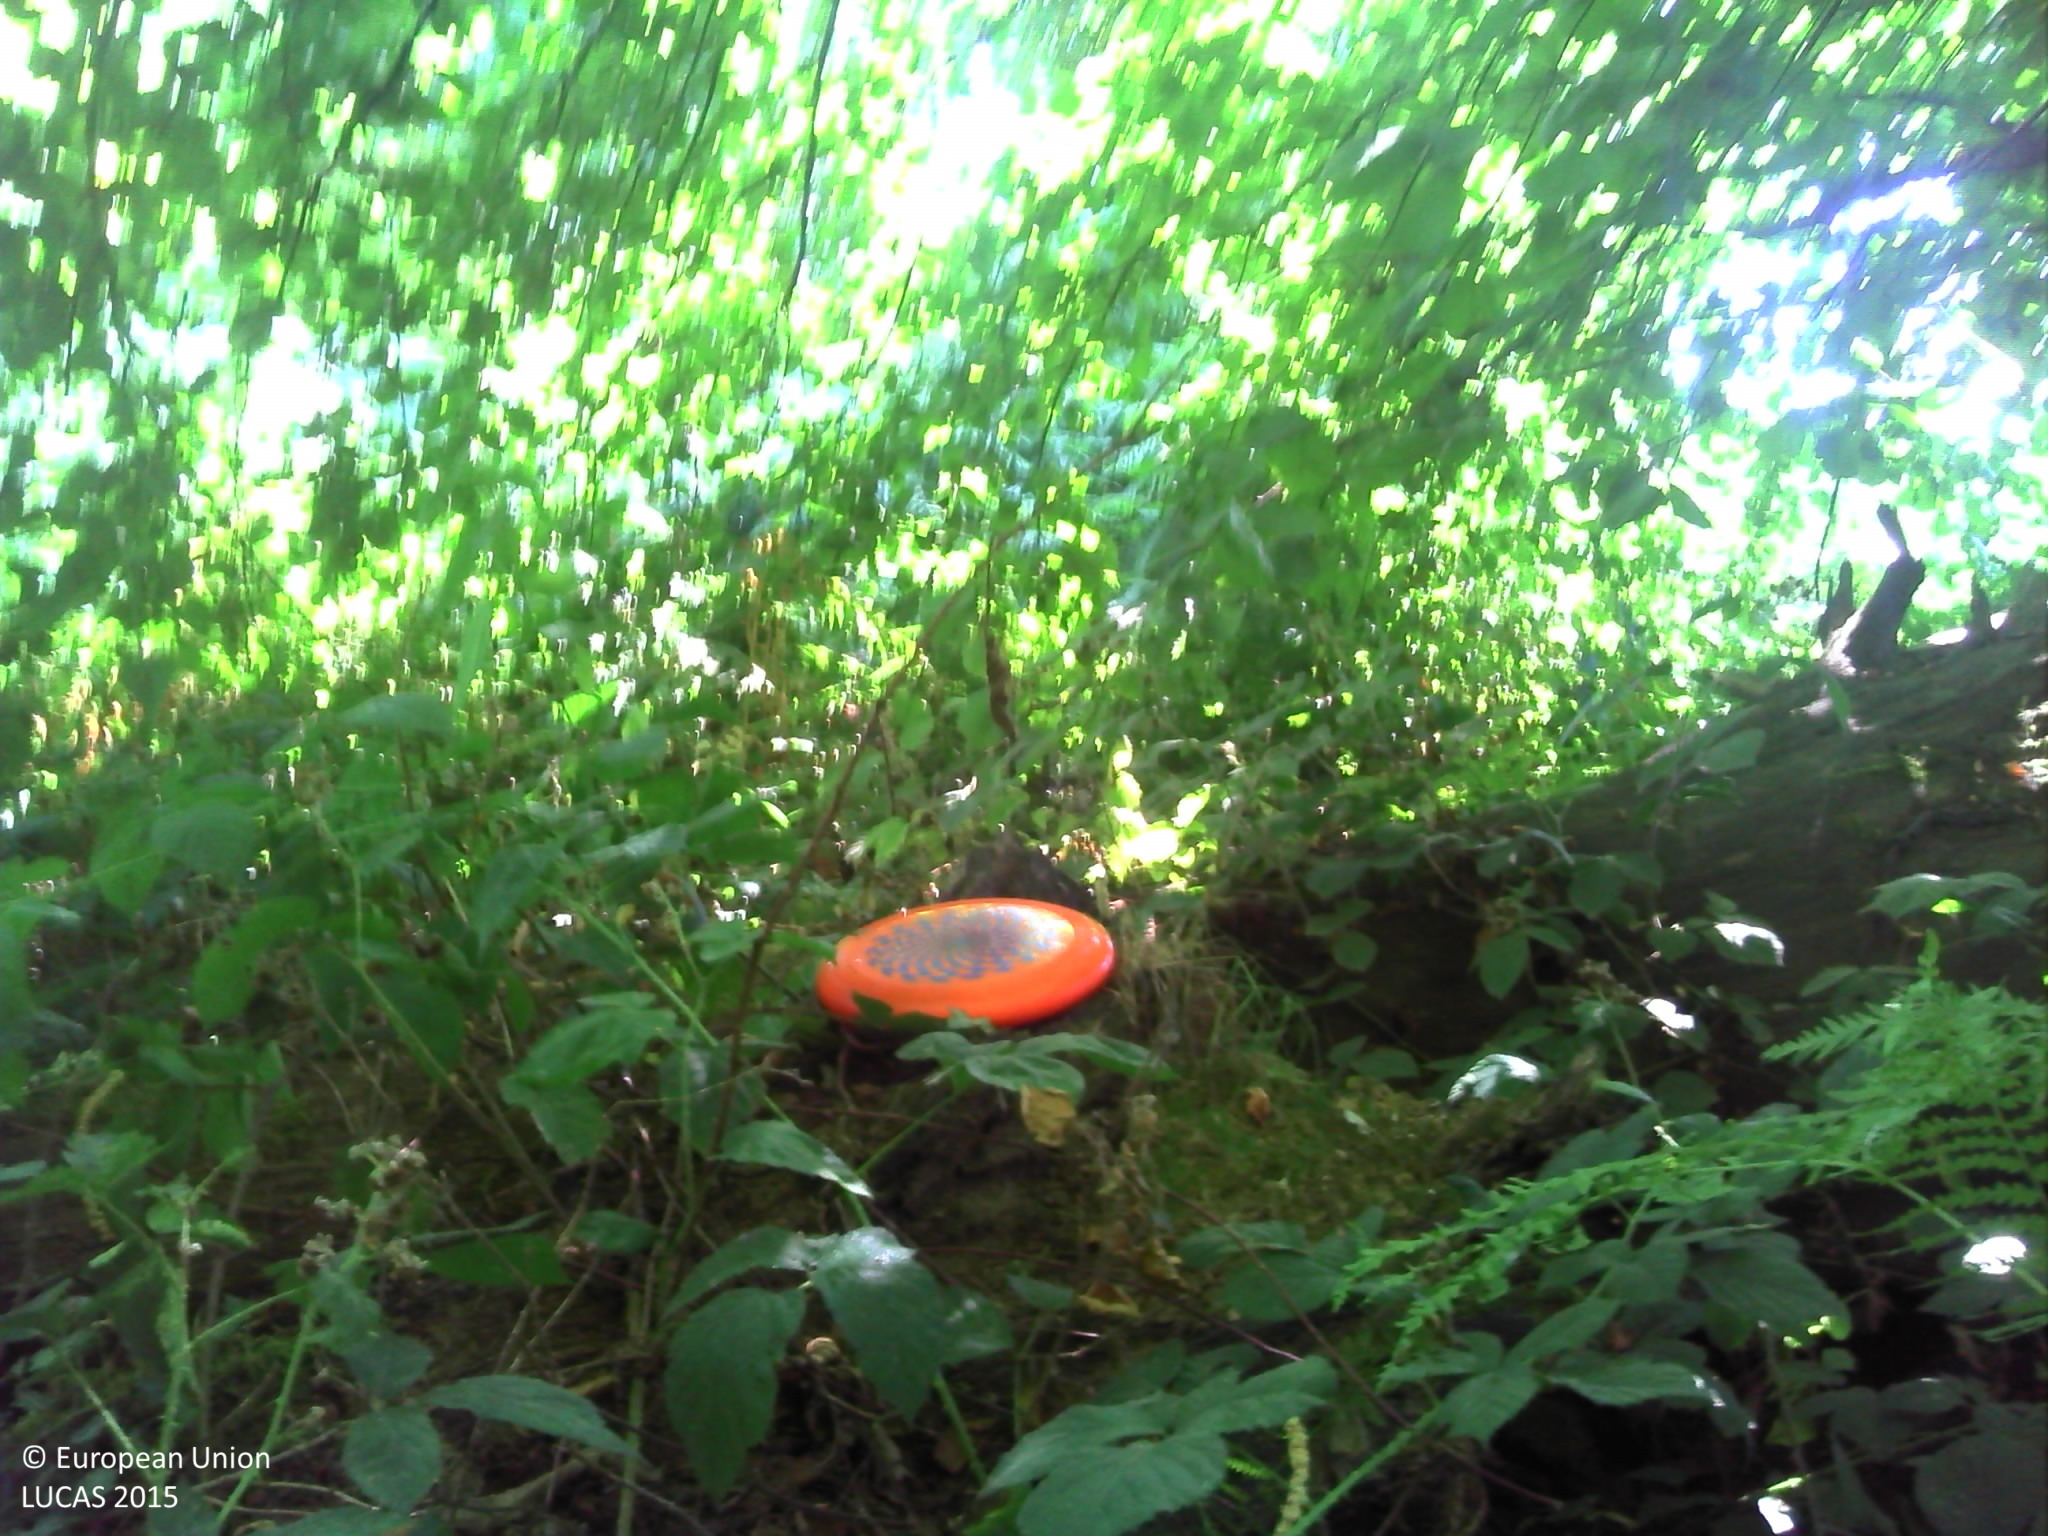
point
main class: Woodland
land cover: Broadleaved woodland
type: mesophytic deciduous forest
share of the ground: > 75 %
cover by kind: broadleaved forest trees 90 %, coniferous forest trees 5 %, lichens and mosses 5 %
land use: Forestry
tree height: > 5 m
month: July
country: FR
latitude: 46.1583
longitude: 1.7436
